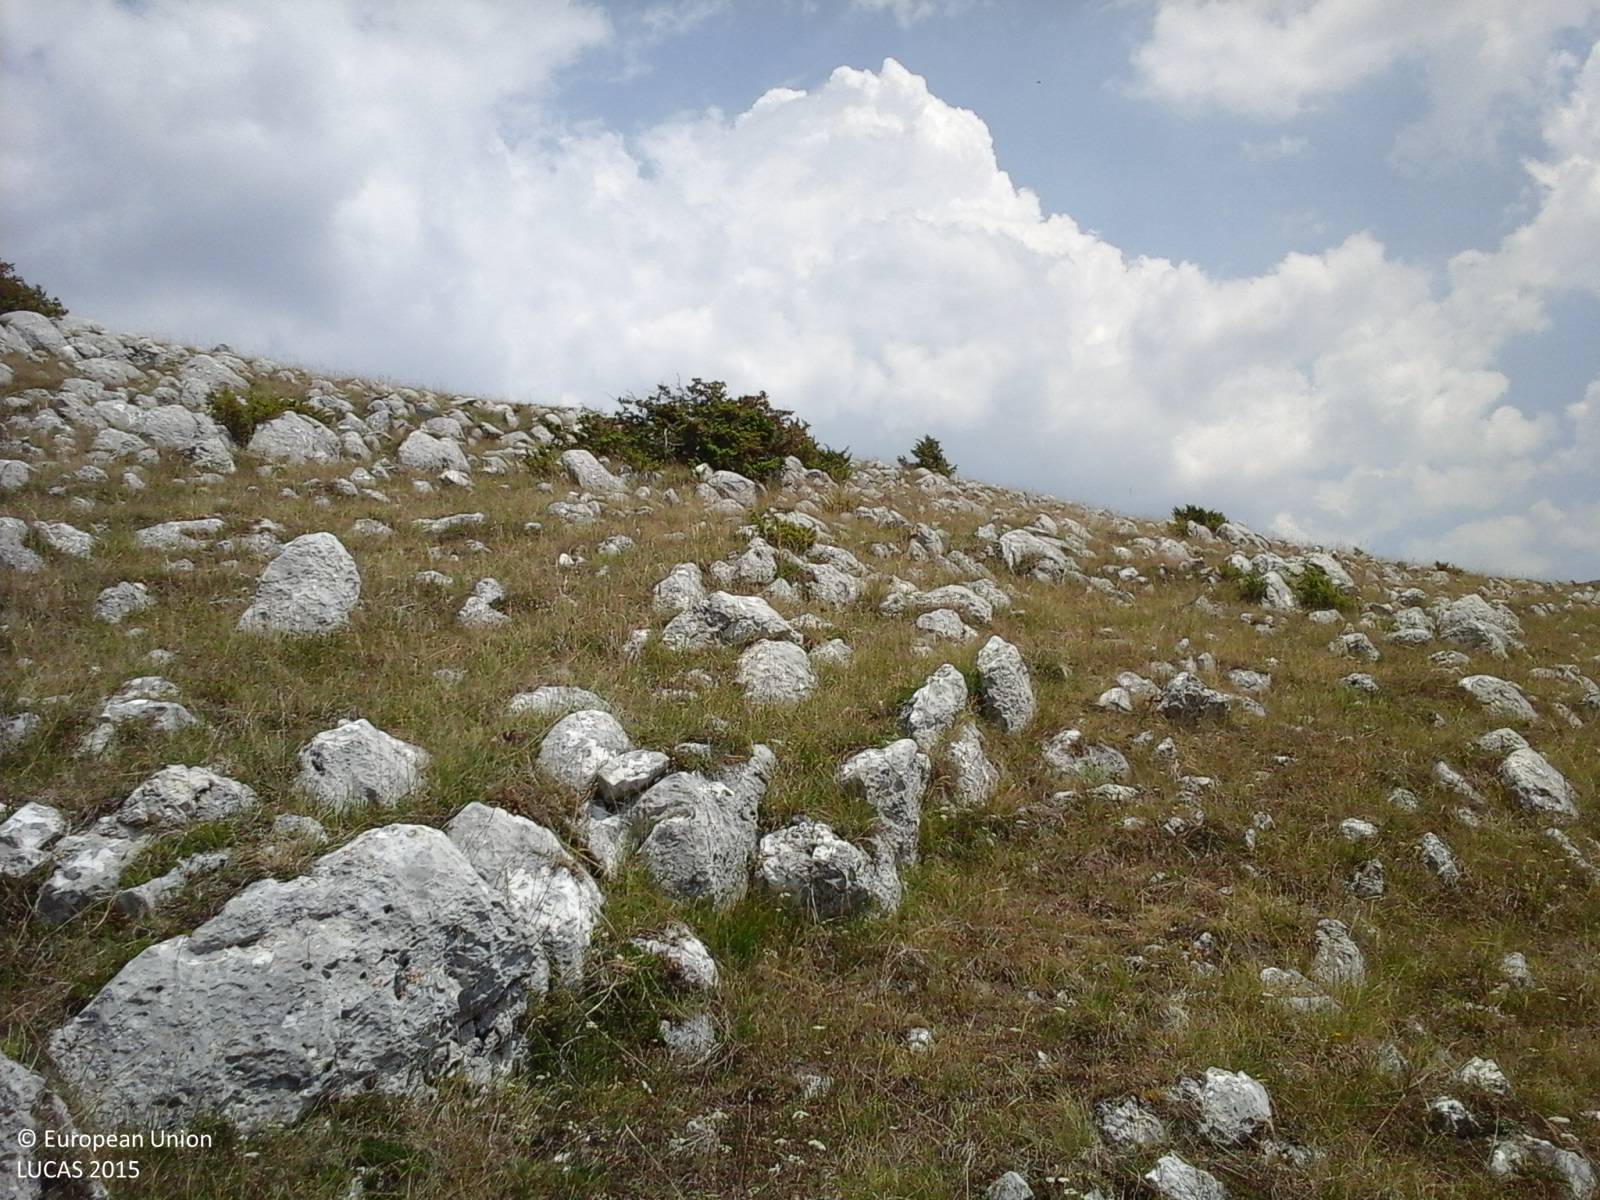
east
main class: Grassland
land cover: Grassland without tree/shrub cover
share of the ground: > 75 %
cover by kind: herbaceous plants 60 %, consolidated bare surface 40 %
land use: Agriculture (excluding fallow land and kitchen gardens)
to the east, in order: Grassland without tree/shrub cover
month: July
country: IT
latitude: 42.2741
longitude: 13.3234
